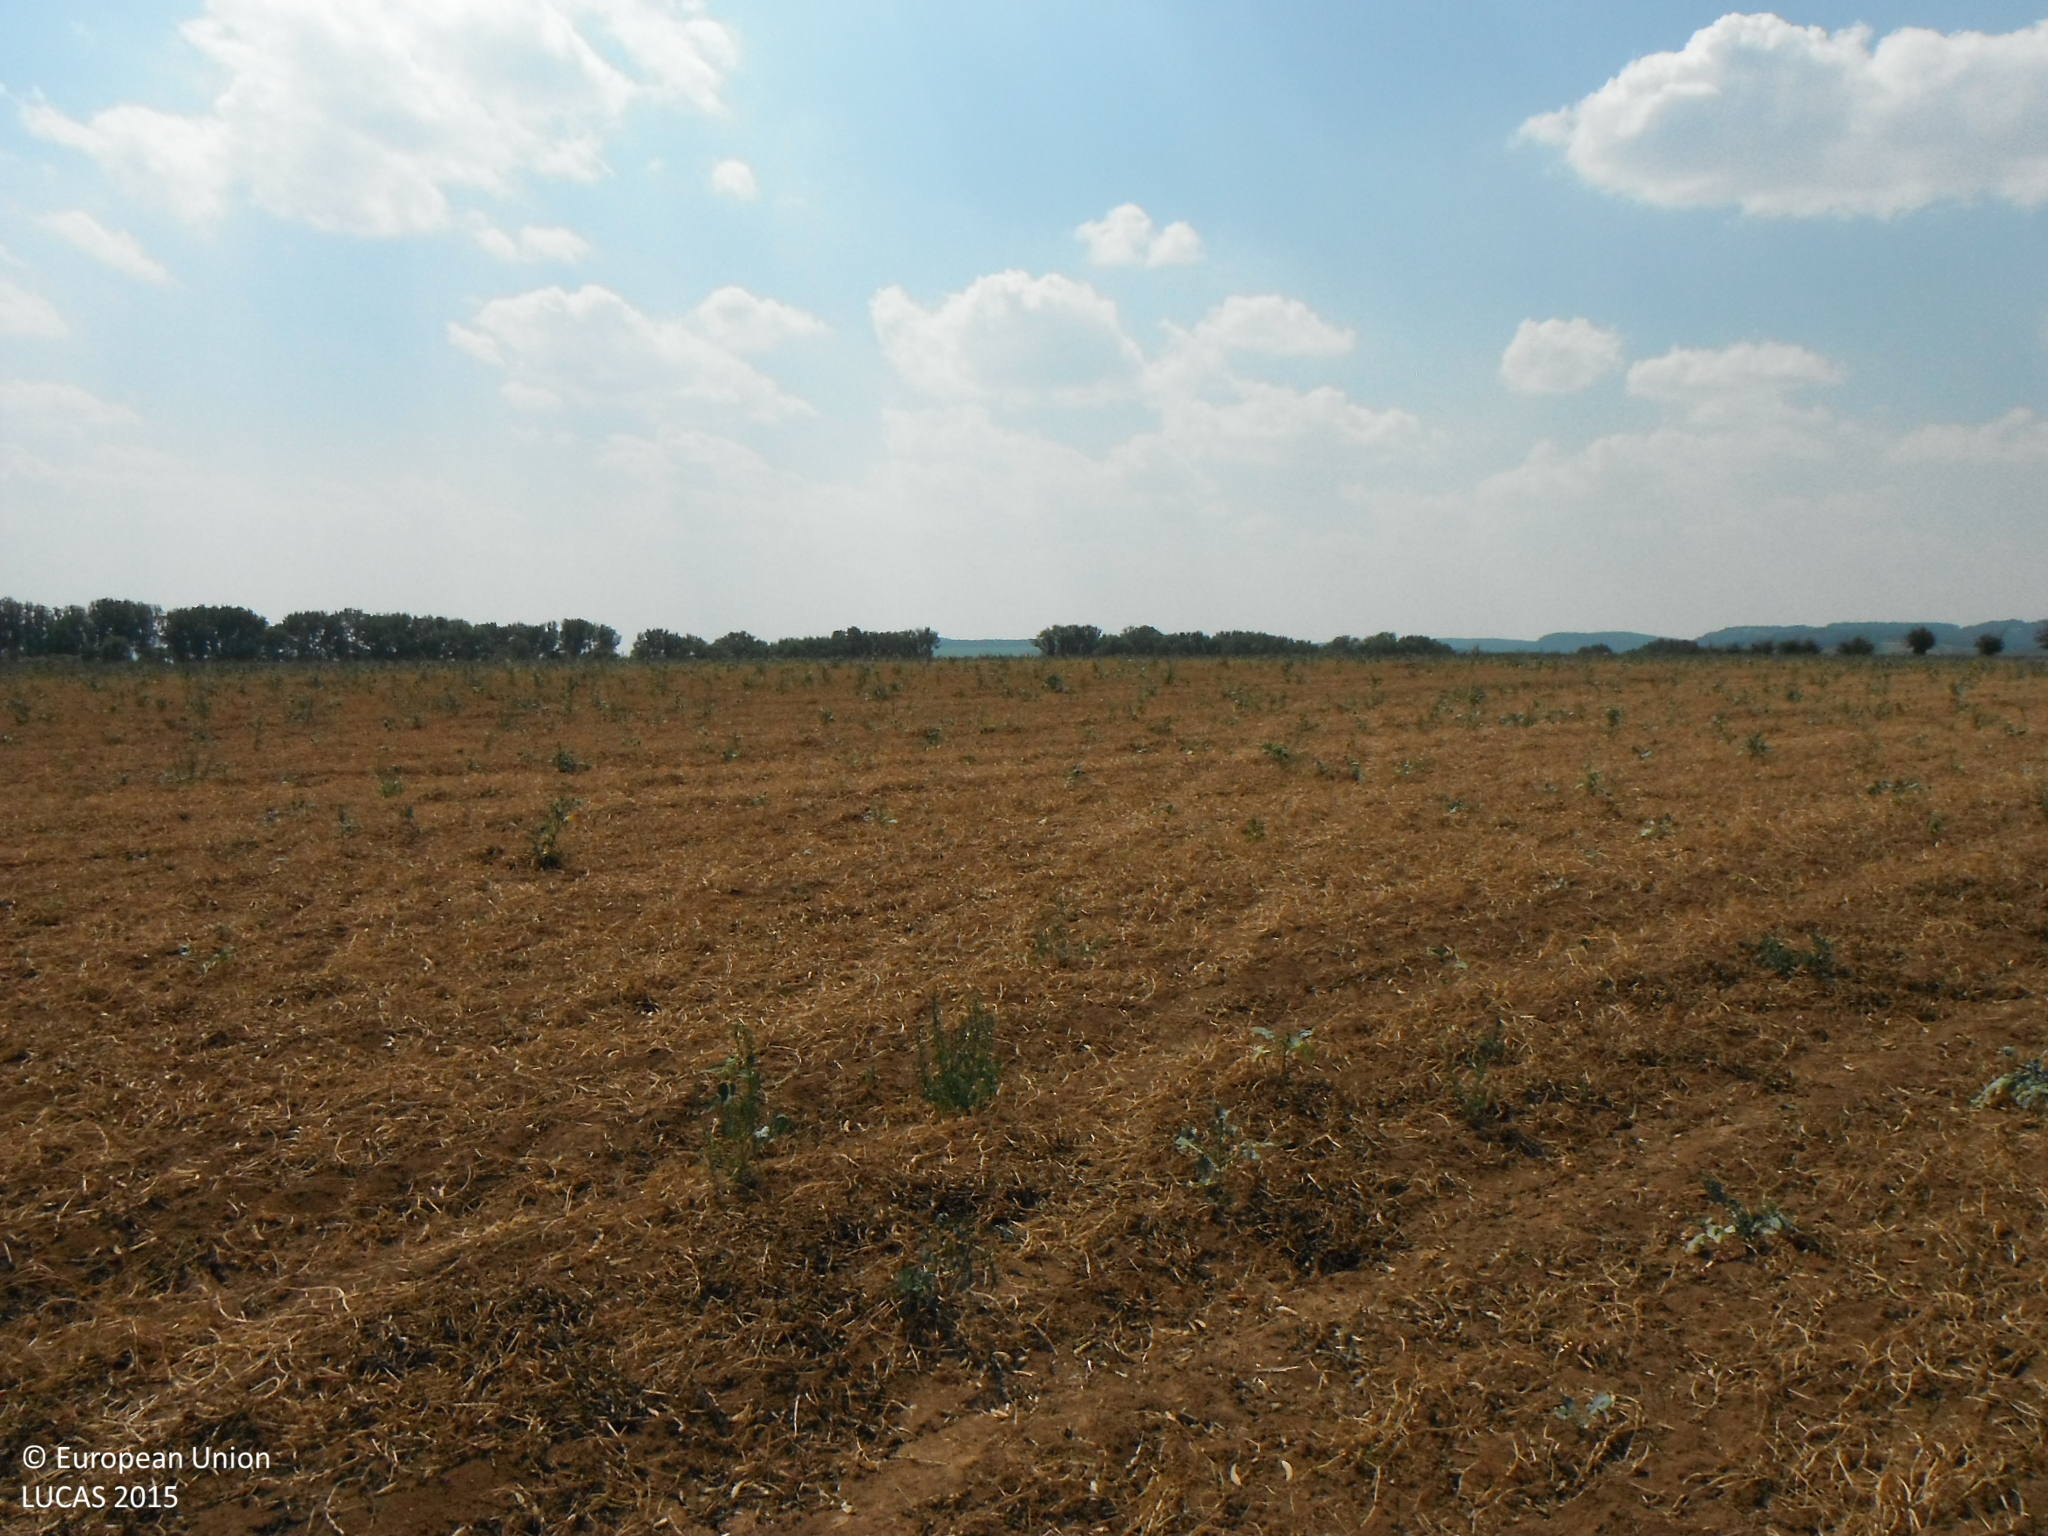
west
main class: Cropland
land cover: Dry pulses
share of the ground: > 75 %
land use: Agriculture (excluding fallow land and kitchen gardens)
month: July
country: SK
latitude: 48.0991
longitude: 19.1113
